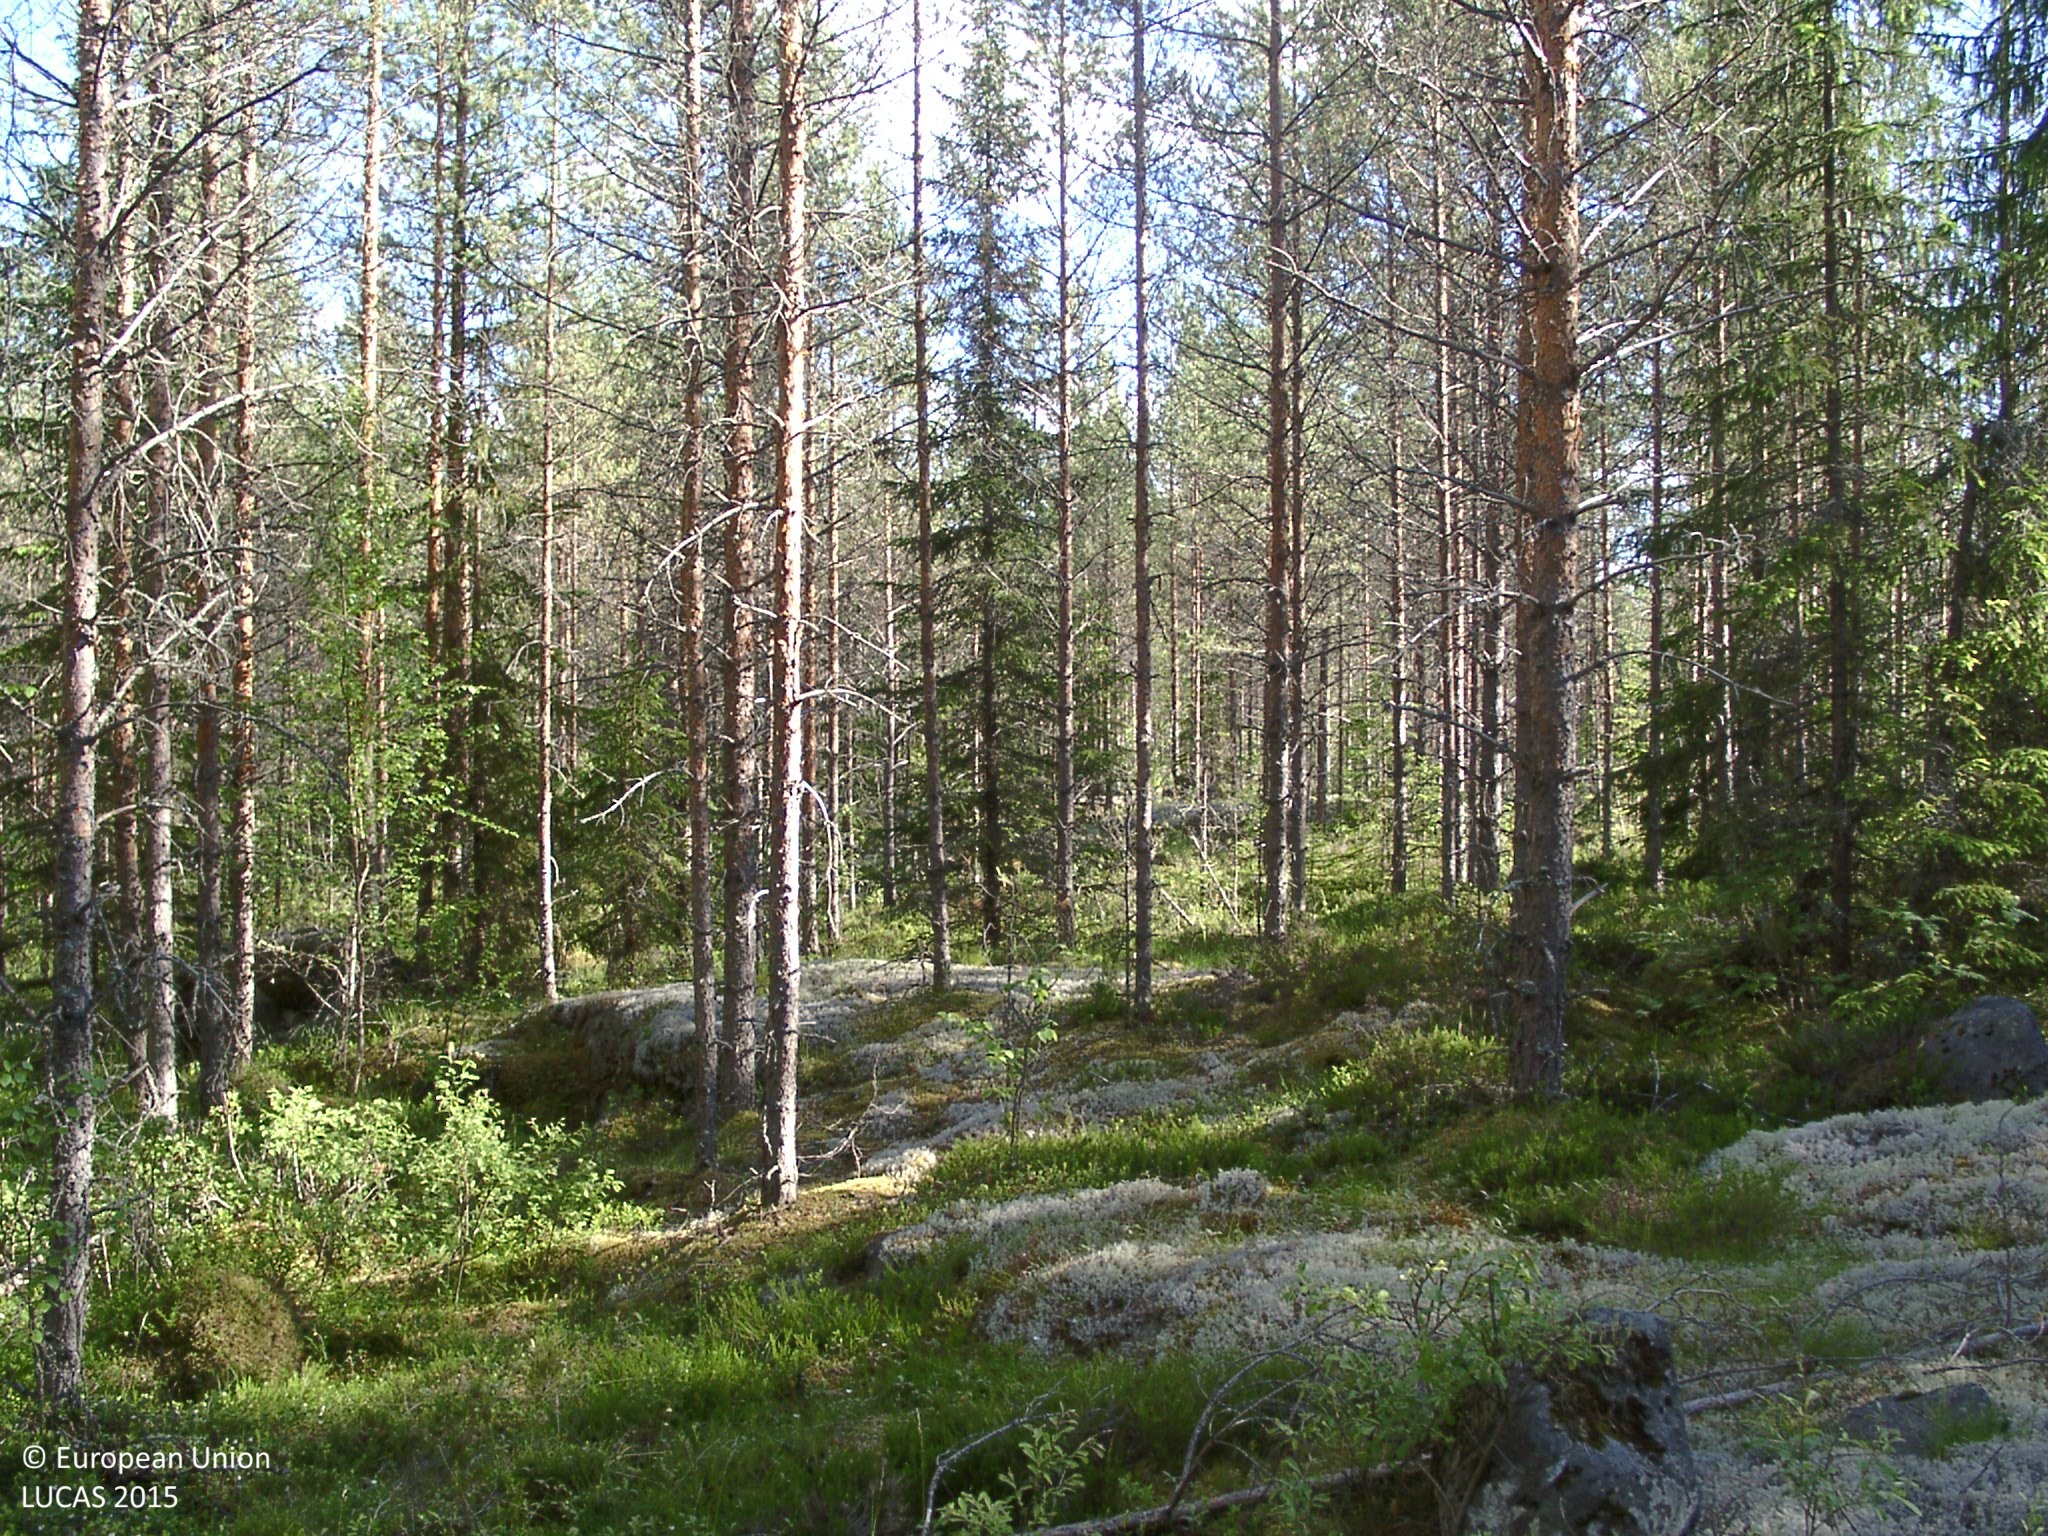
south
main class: Woodland
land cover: Pine dominated coniferous woodland
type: boreal forest
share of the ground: 50 - 75 %
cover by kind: coniferous forest trees 50 %, shrubs 35 %, lichens and mosses 10 %, herbaceous plants 5 %
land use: Semi-natural and natural areas not in use
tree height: > 5 m
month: June
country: FI
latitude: 62.1206
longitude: 24.9202
